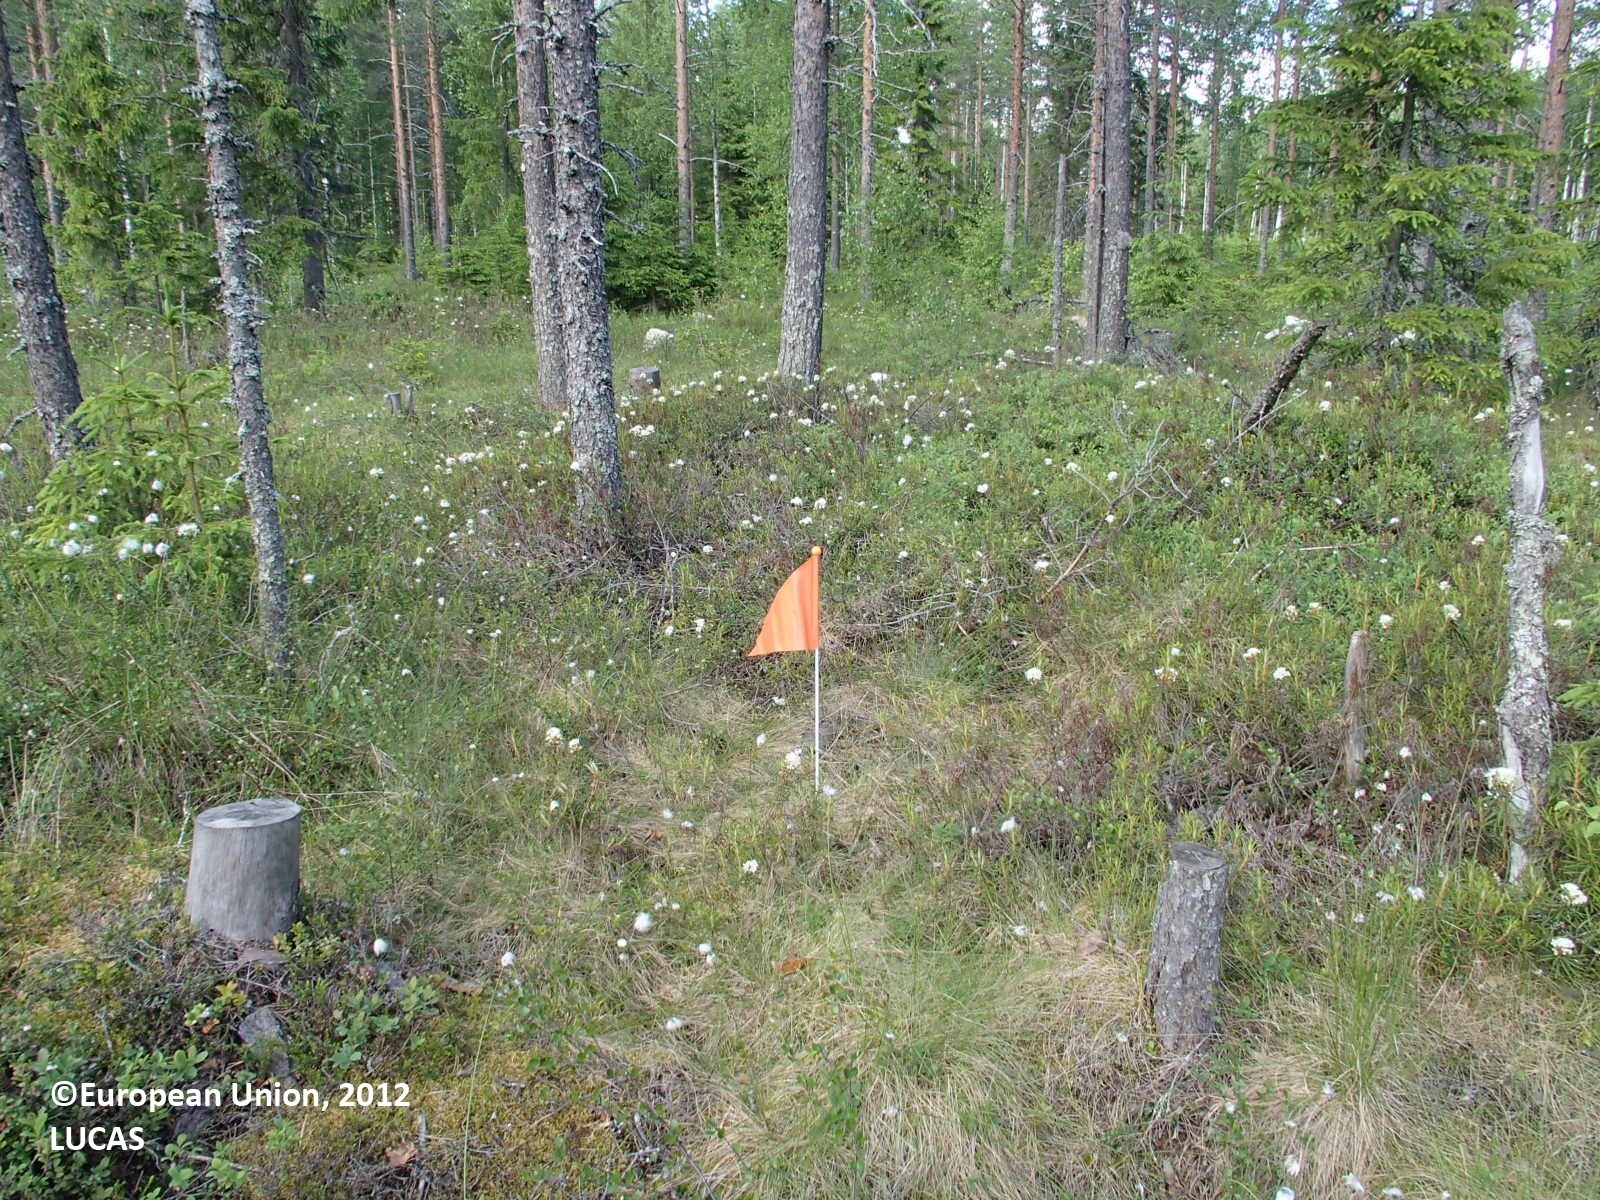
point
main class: Woodland
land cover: Pine dominated coniferous woodland
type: boreal forest
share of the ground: > 75 %
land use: Forestry
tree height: > 5 m
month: June
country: FI
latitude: 64.0165
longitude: 26.9284
